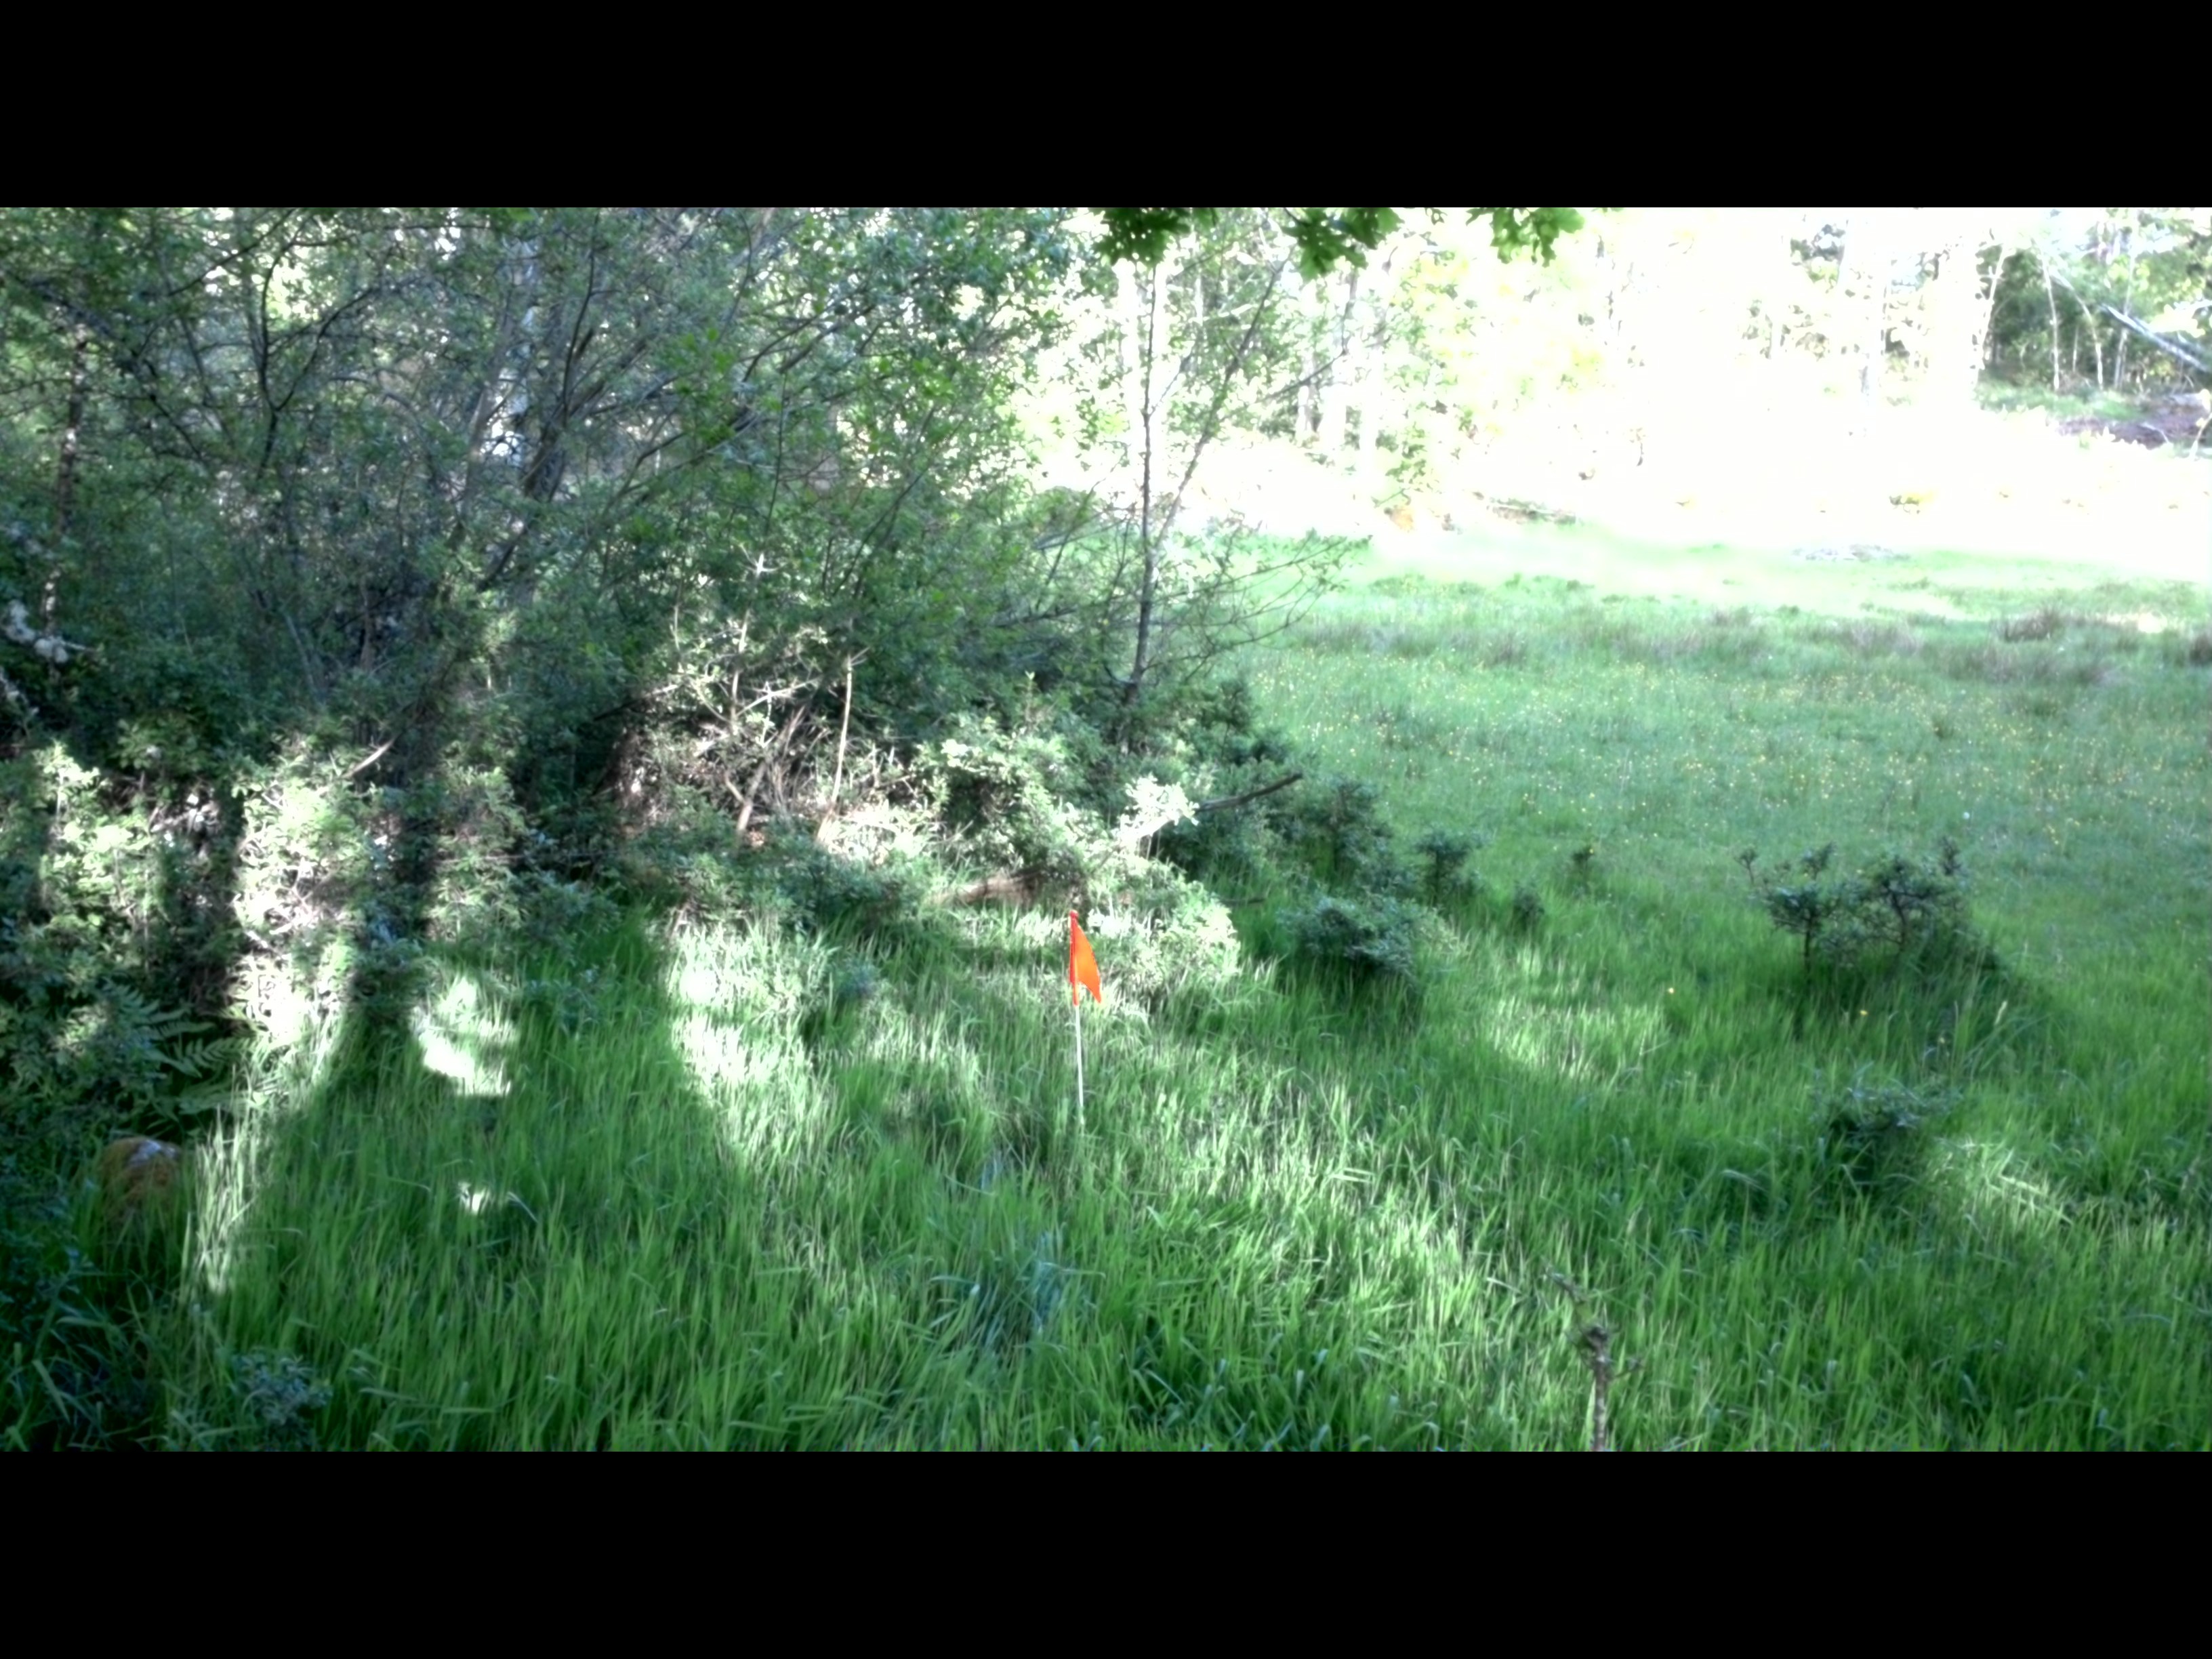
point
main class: Woodland
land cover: Broadleaved woodland
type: hemiboreal forest and nemoral coniferous forest and mixed broadleaved-coniferous forest
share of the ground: 25 - 50 %
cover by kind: broadleaved forest trees 50 %, herbaceous plants 30 %, shrubs 20 %
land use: Agriculture (excluding fallow land and kitchen gardens)
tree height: > 5 m
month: May
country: SE
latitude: 57.2884
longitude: 16.4536
